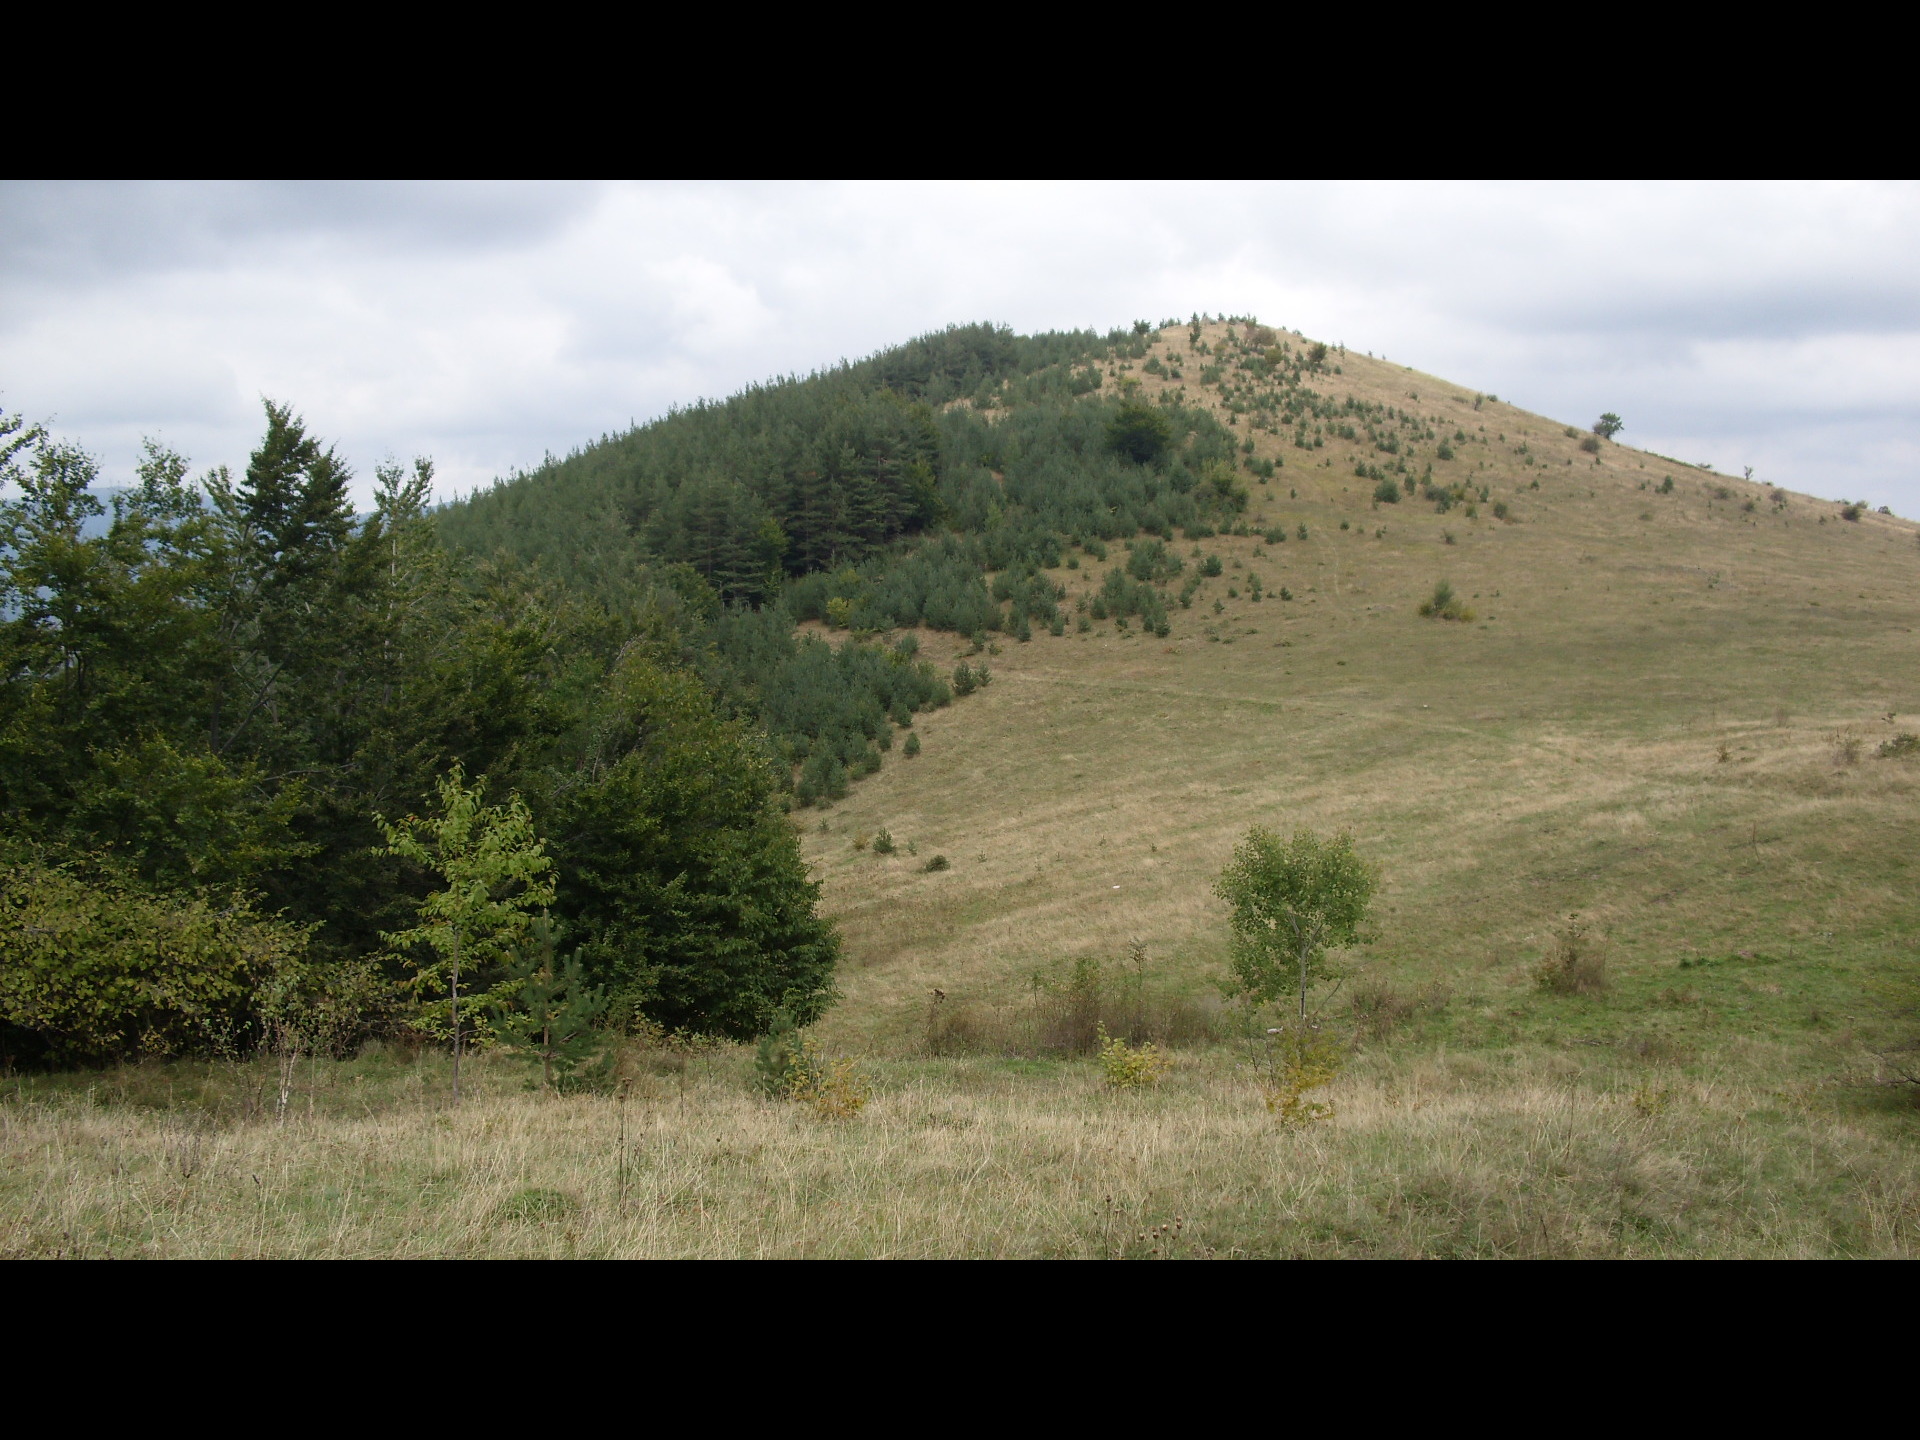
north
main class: Grassland
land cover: Grassland with sparse tree/shrub cover
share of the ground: > 75 %
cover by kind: herbaceous plants 90 %, broadleaved forest trees 5 %, shrubs 5 %
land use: Agriculture (excluding fallow land and kitchen gardens)
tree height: < 5 m
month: October
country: BG
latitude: 43.3470
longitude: 22.8512
